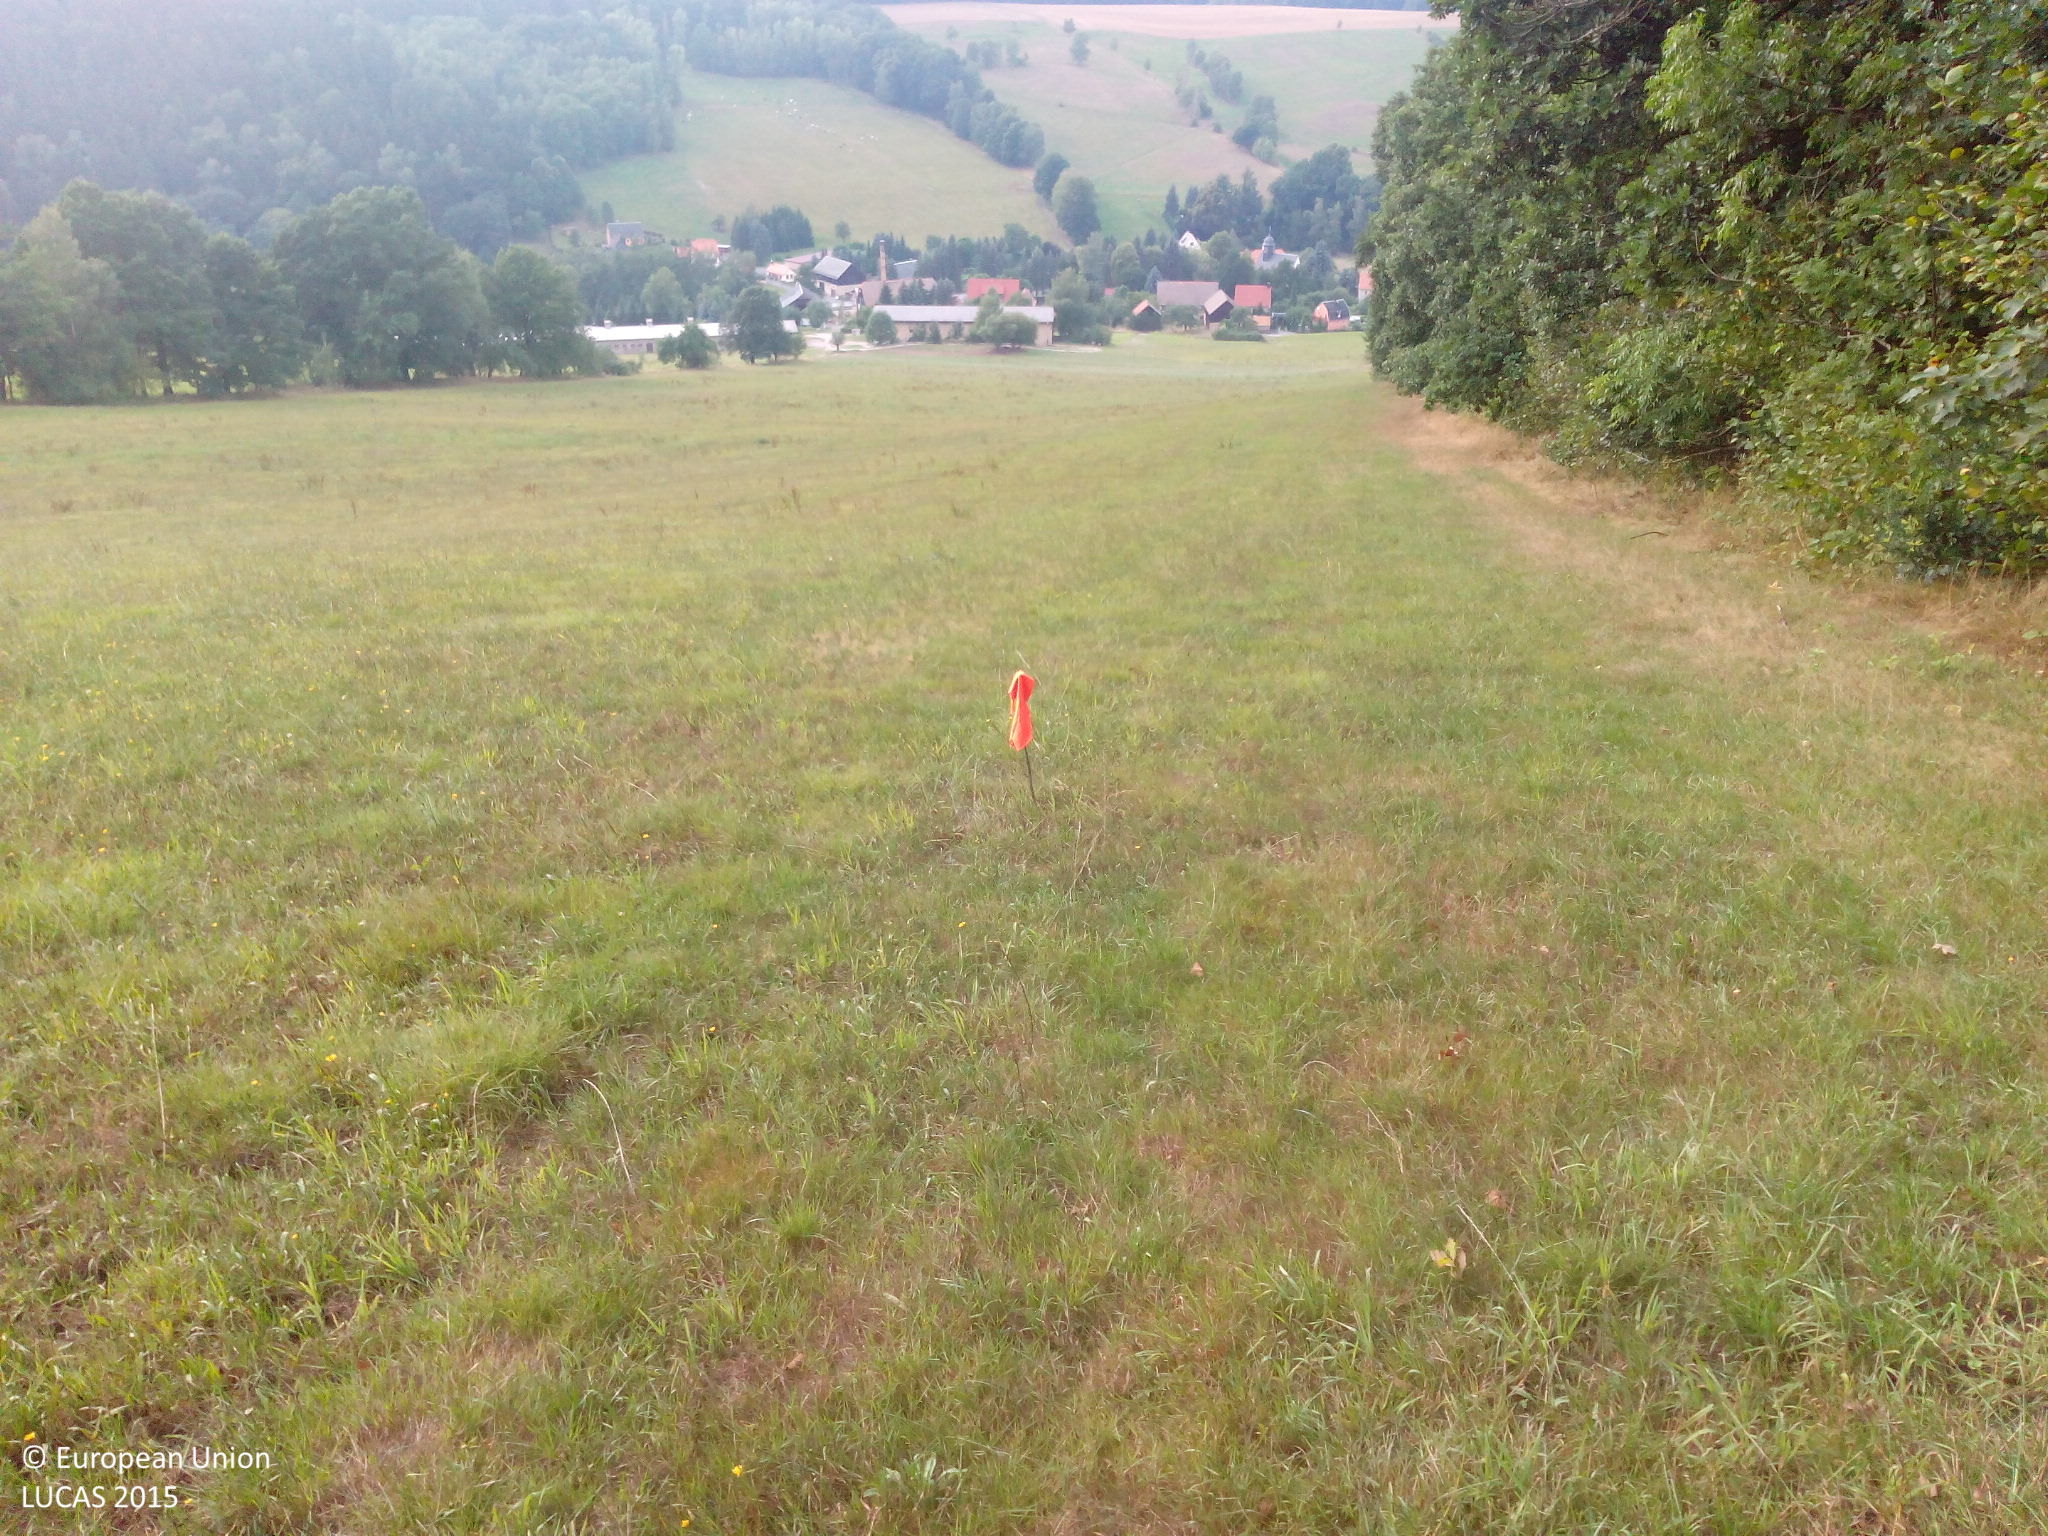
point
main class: Grassland
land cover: Grassland without tree/shrub cover
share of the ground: > 75 %
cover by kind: herbaceous plants 100 %
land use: Agriculture (excluding fallow land and kitchen gardens)
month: August
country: DE
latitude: 50.8345
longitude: 13.9910
